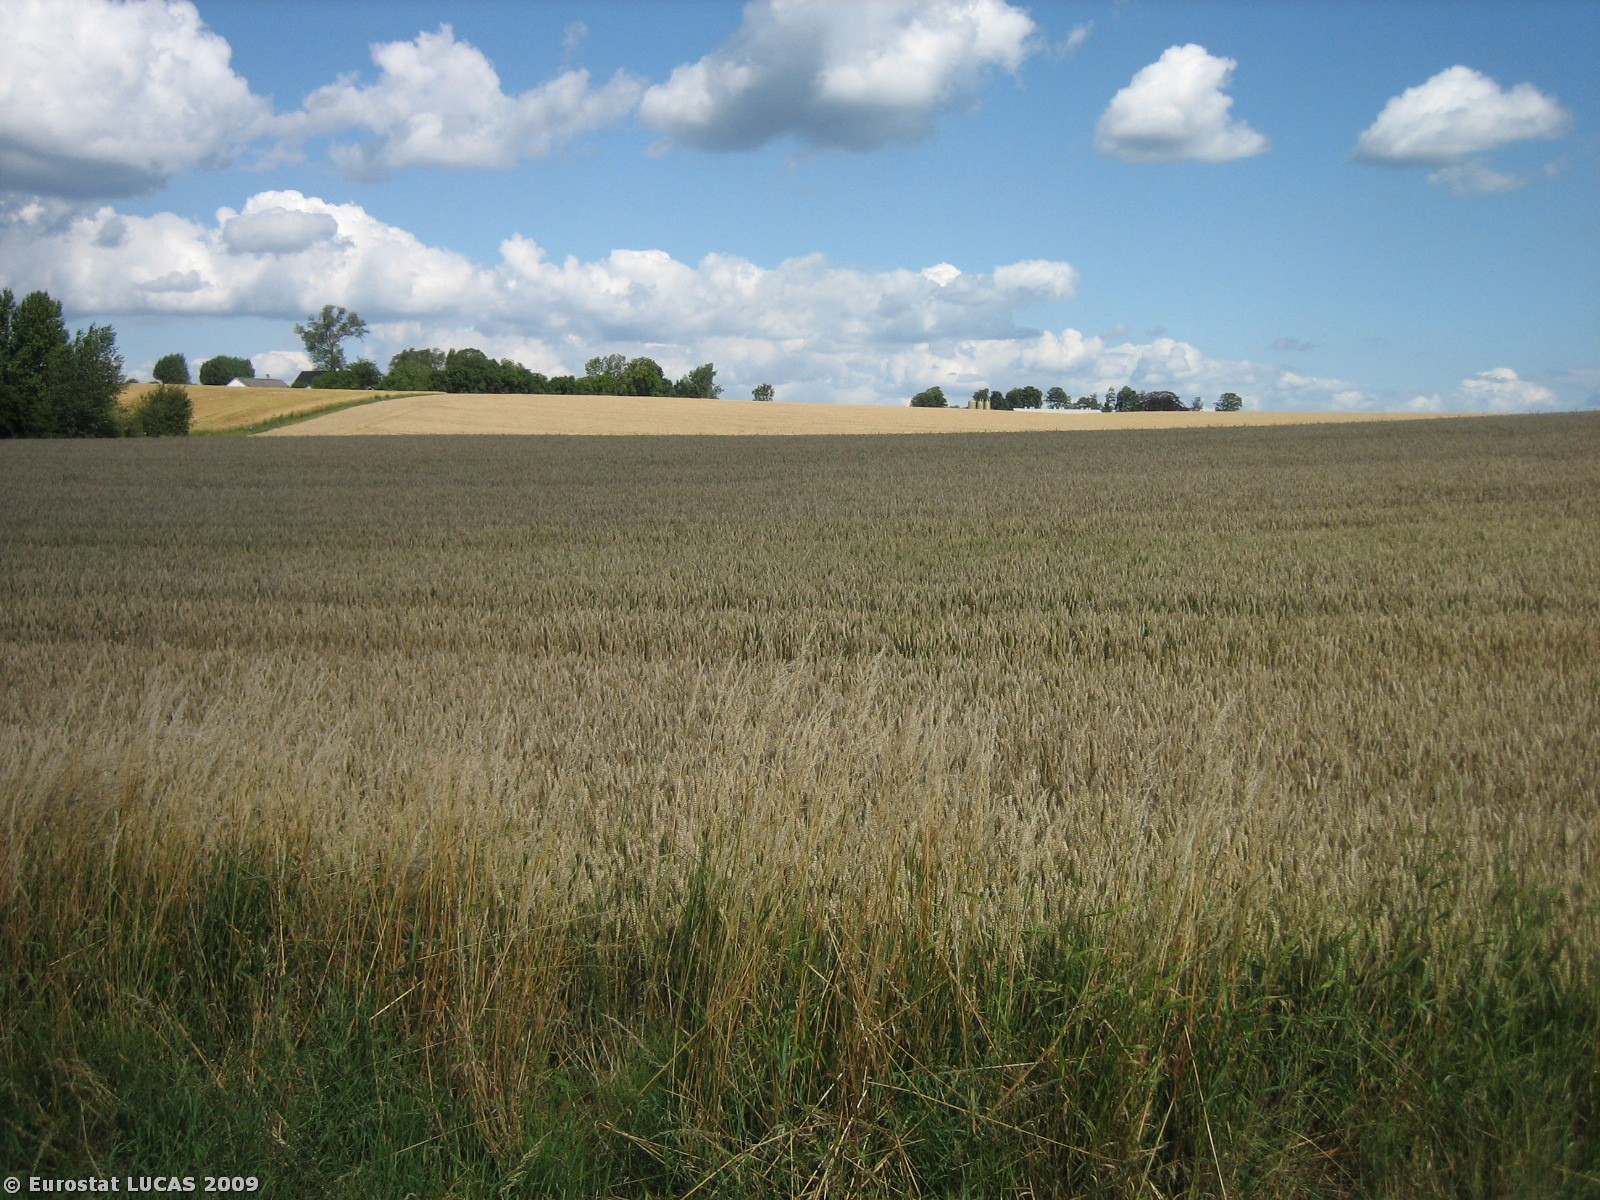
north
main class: Cropland
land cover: Common wheat
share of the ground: > 75 %
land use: Agriculture (excluding fallow land and kitchen gardens)
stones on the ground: 10 - 25 %
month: July
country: DK
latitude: 55.4867
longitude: 9.9209
